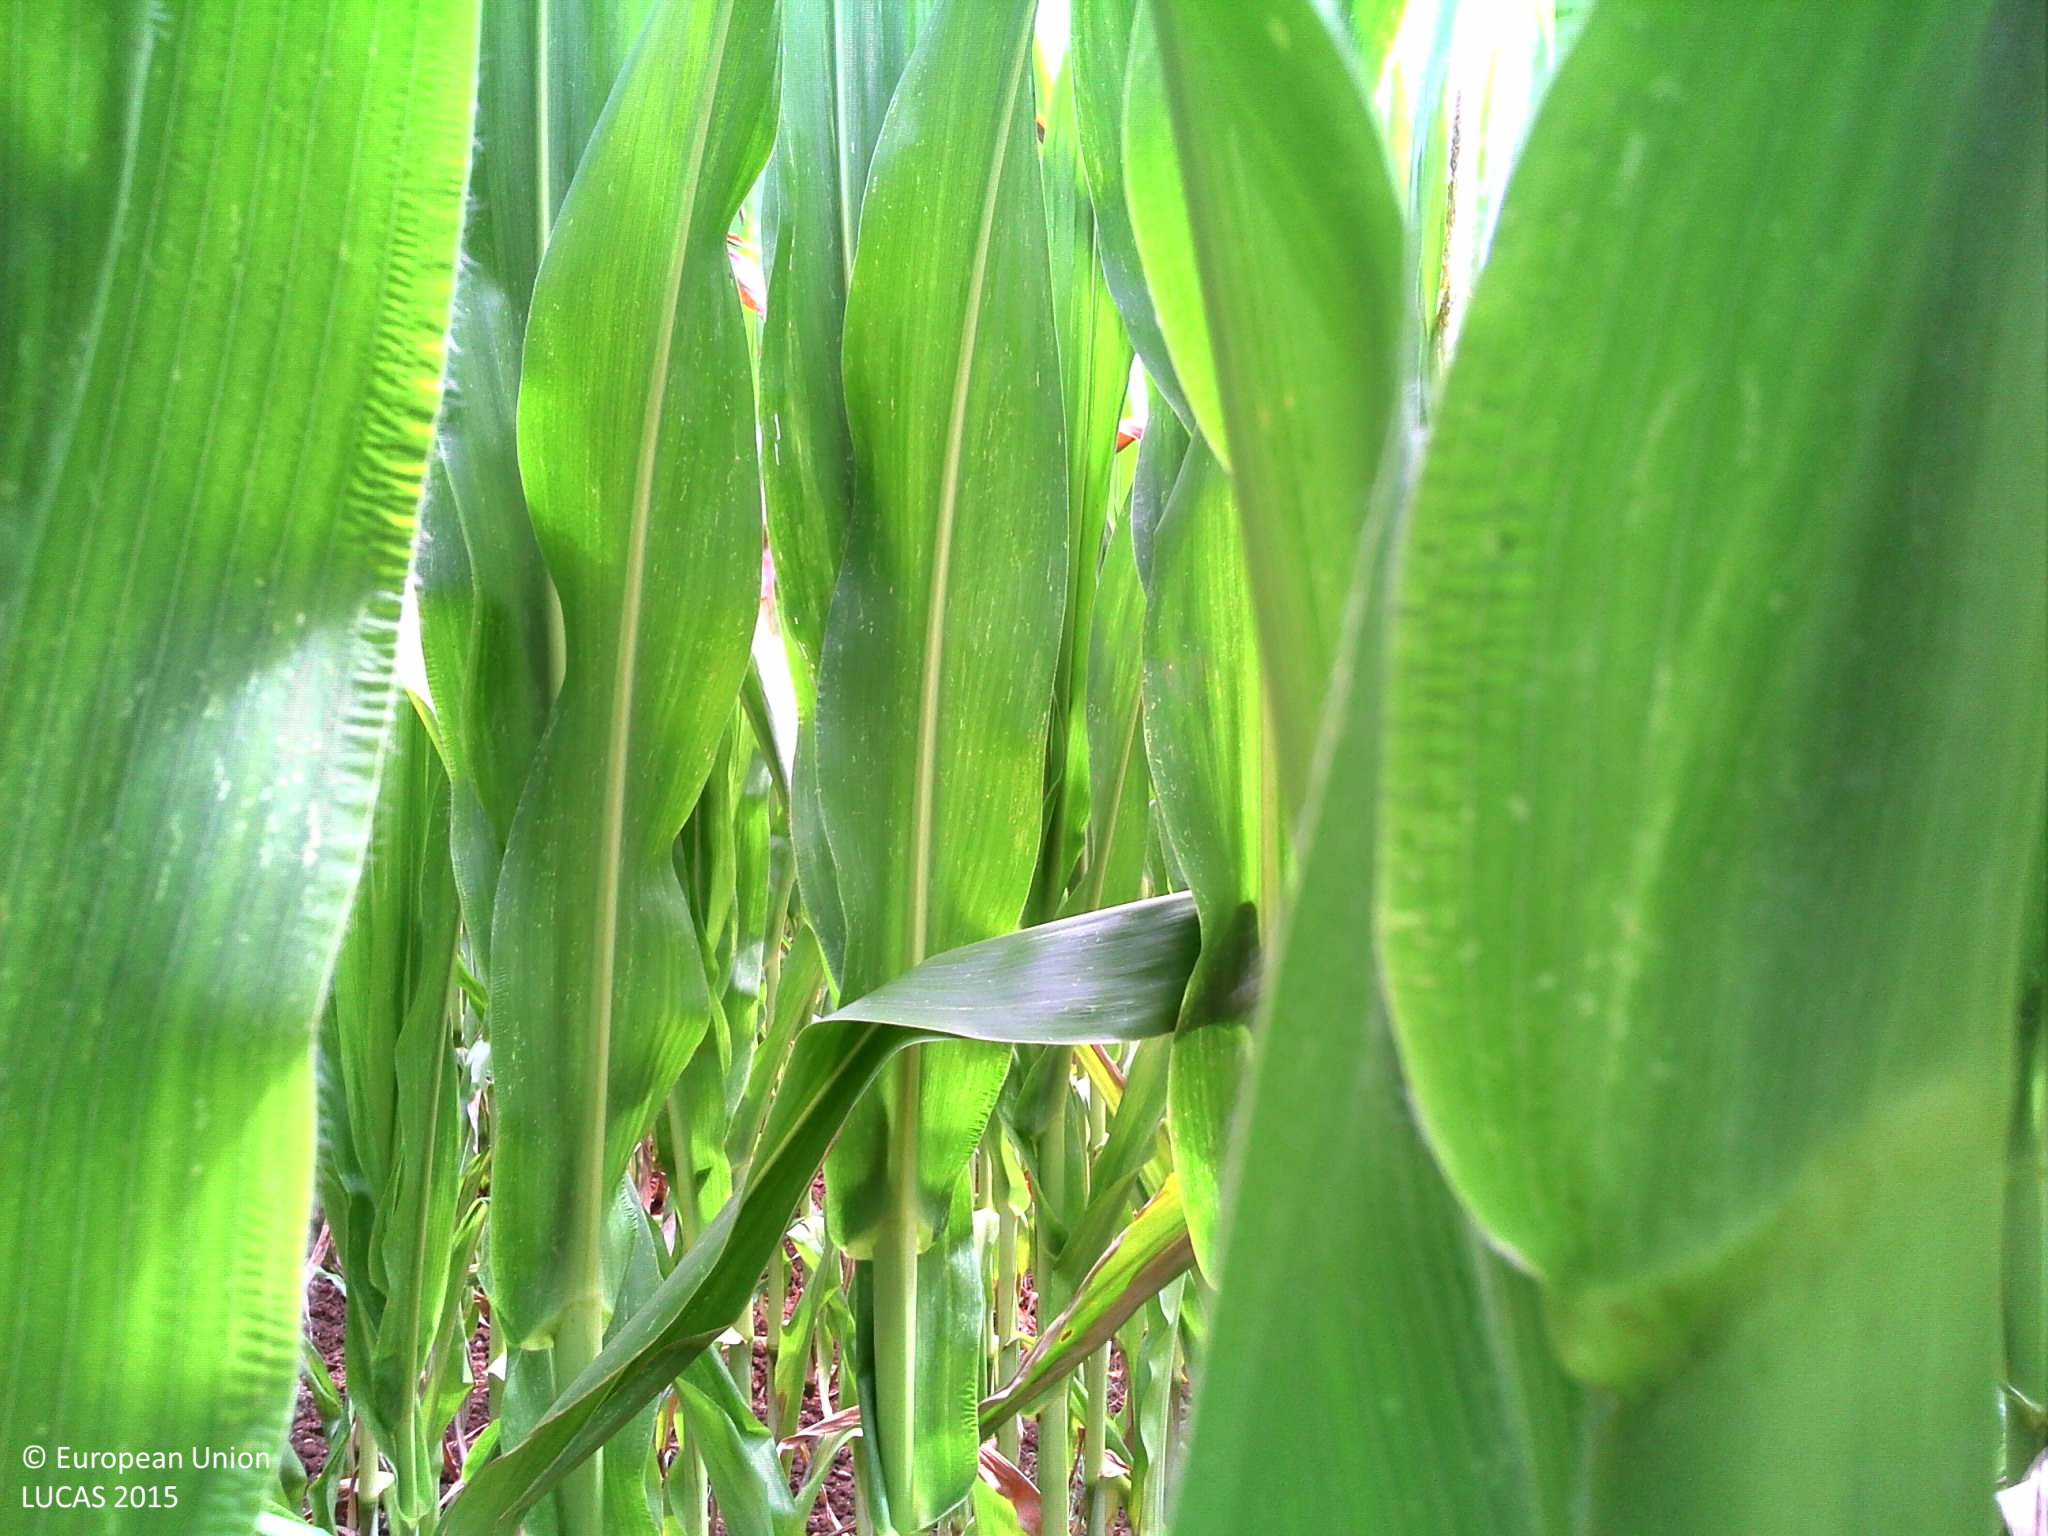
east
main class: Cropland
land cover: Maize
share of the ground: > 75 %
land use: Agriculture (excluding fallow land and kitchen gardens)
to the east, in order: Maize; Ditches and canals; Maize; Fences; Grassland with sparse tree/shrub cover; Fences; Maize
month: July
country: FR
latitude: 44.8520
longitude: 0.8443
